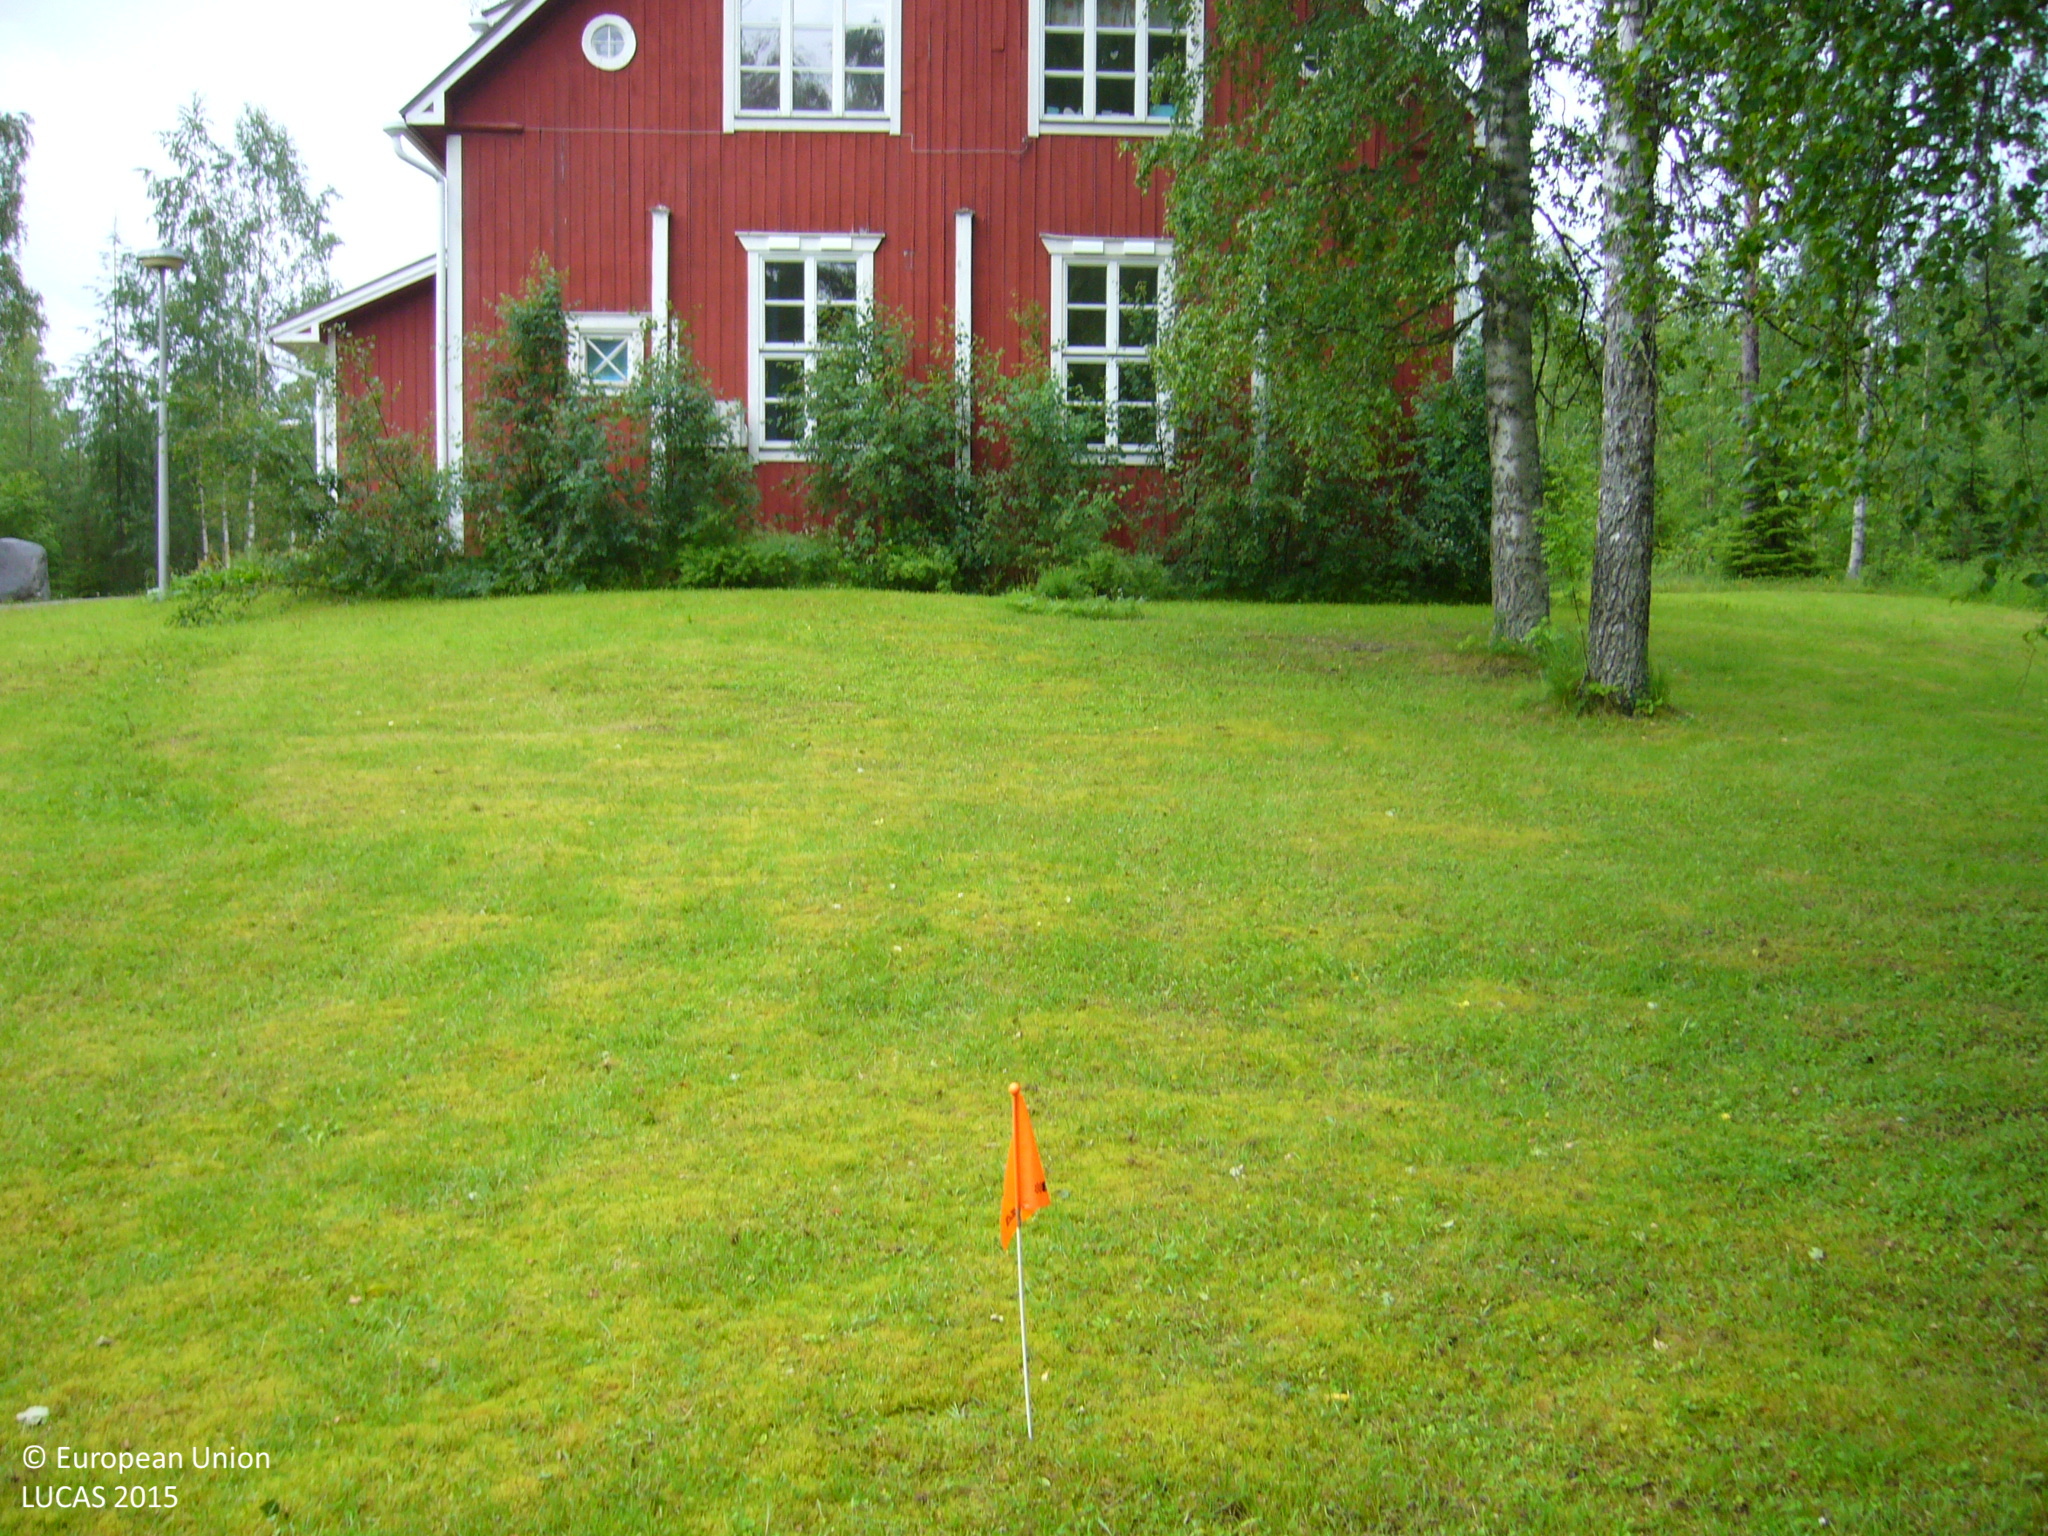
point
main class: Grassland
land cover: Grassland with sparse tree/shrub cover
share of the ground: > 75 %
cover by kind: herbaceous plants 95 %, broadleaved forest trees 5 %
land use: Community services
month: July
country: FI
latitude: 63.4040
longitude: 25.5393
